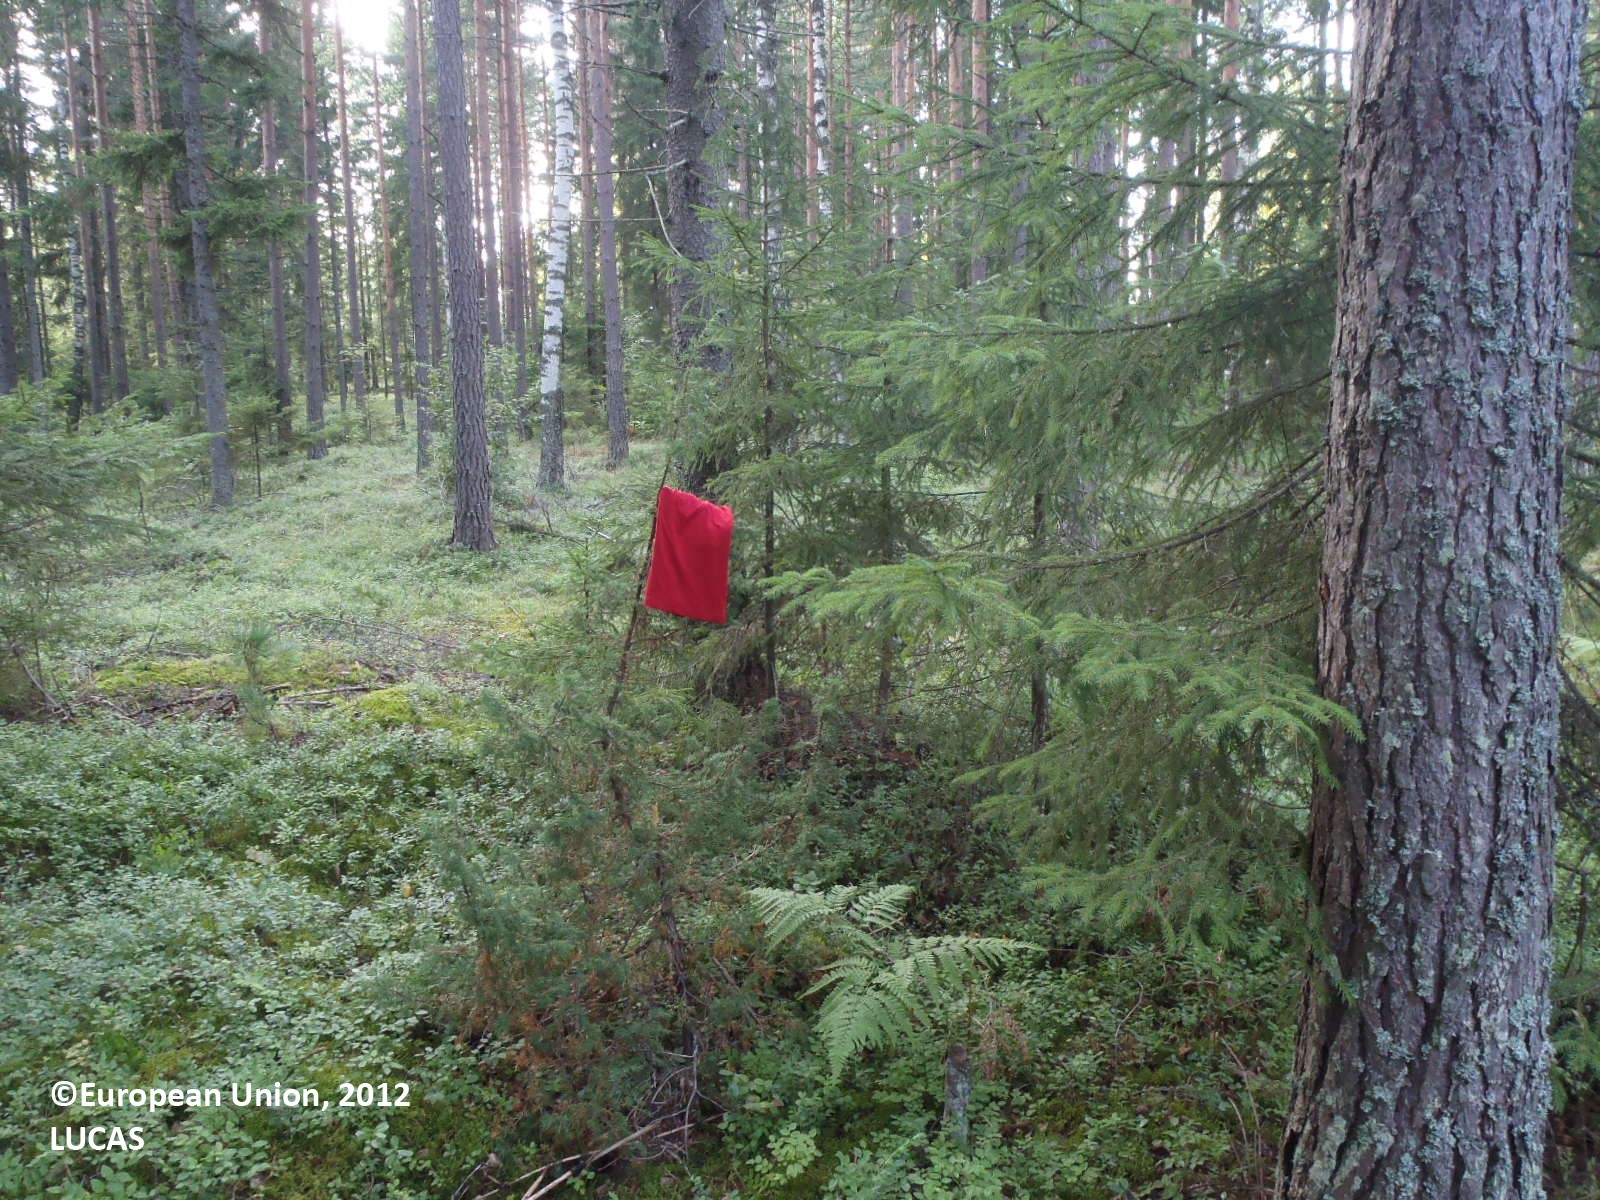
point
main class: Woodland
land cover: Pine dominated coniferous woodland
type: boreal forest
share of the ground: > 75 %
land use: Forestry
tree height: > 5 m
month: August
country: FI
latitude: 60.5738
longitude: 22.6812
